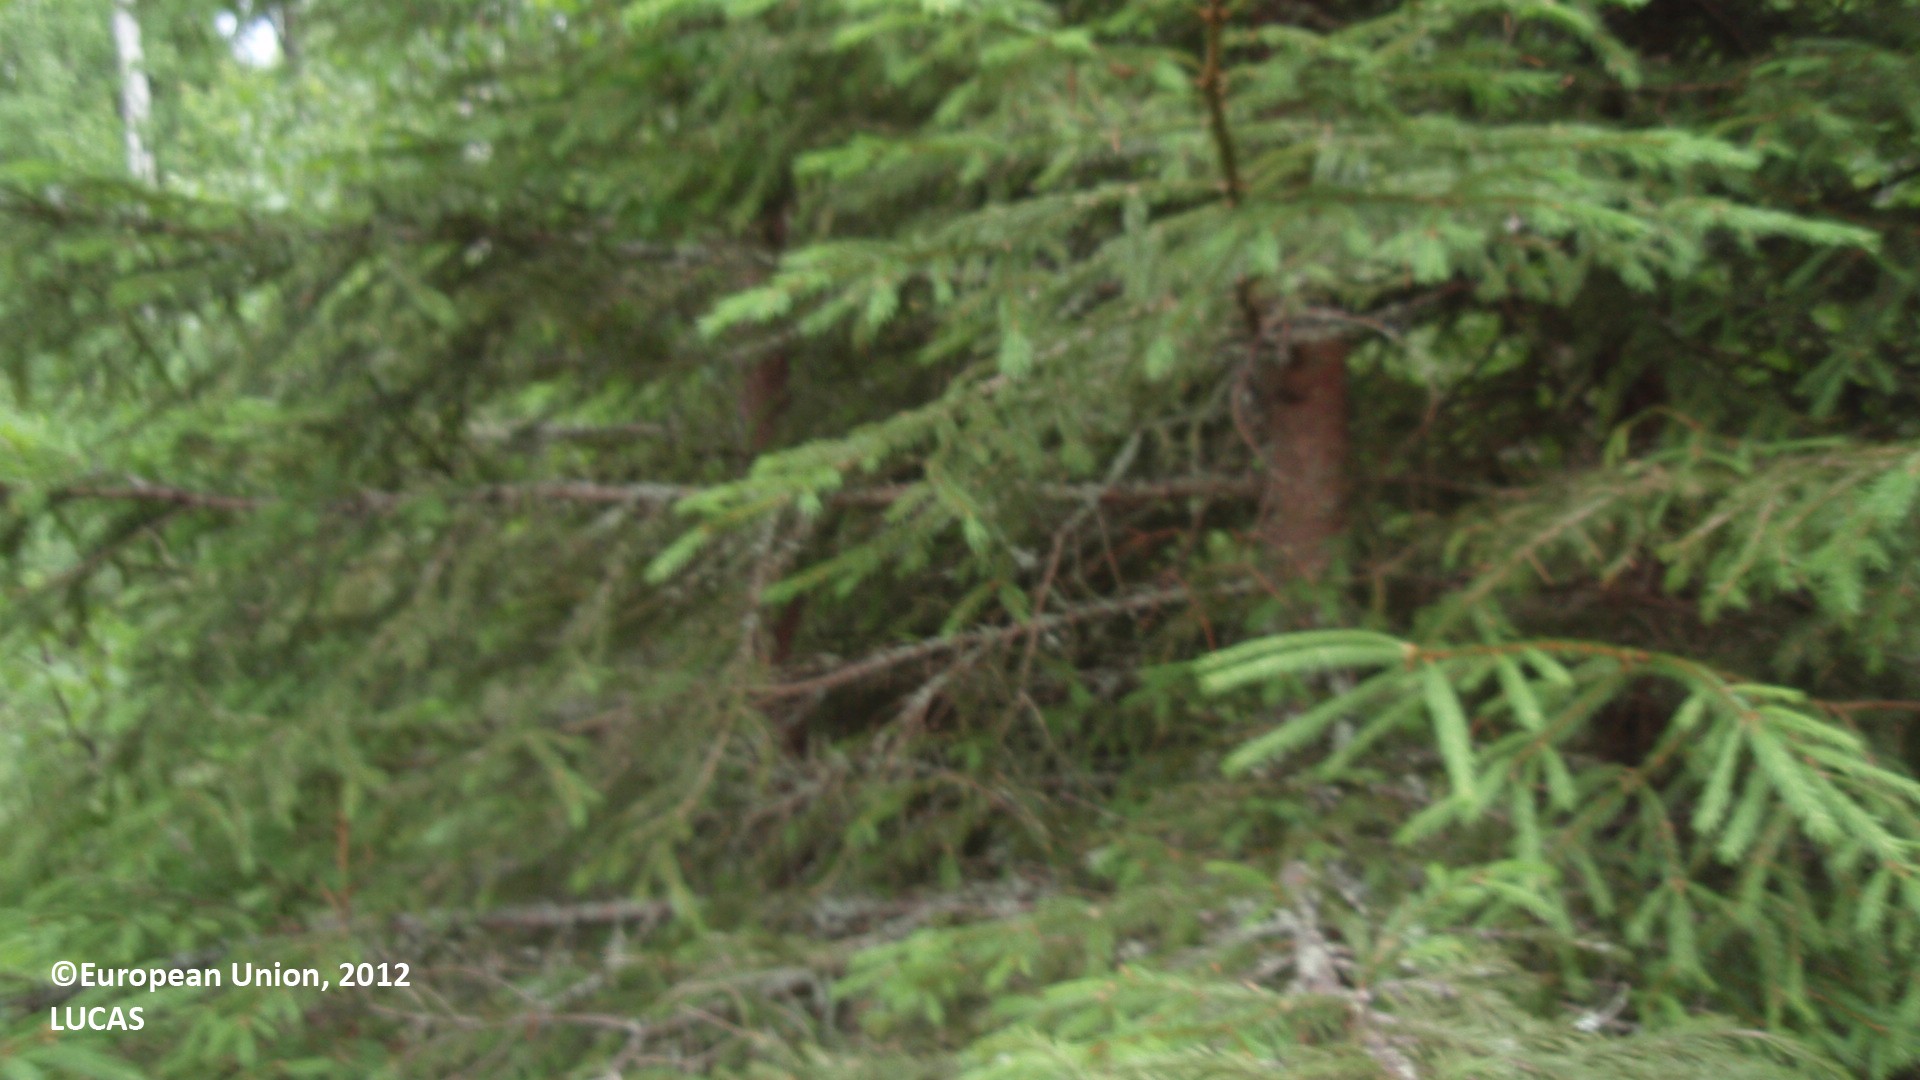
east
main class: Woodland
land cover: Spruce dominated mixed woodland
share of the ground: 50 - 75 %
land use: Forestry
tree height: > 5 m
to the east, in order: Spruce dominated mixed woodland; Grassland with sparse tree/shrub cover; Paved roads, cycling and walking lanes; Grassland with sparse tree/shrub cover; Broadleaved woodland; Pine dominated mixed woodland; Spruce dominated mixed woodland; Broadleaved woodland; Spruce dominated mixed woodland
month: July
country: FI
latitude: 61.4926
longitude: 28.8769
